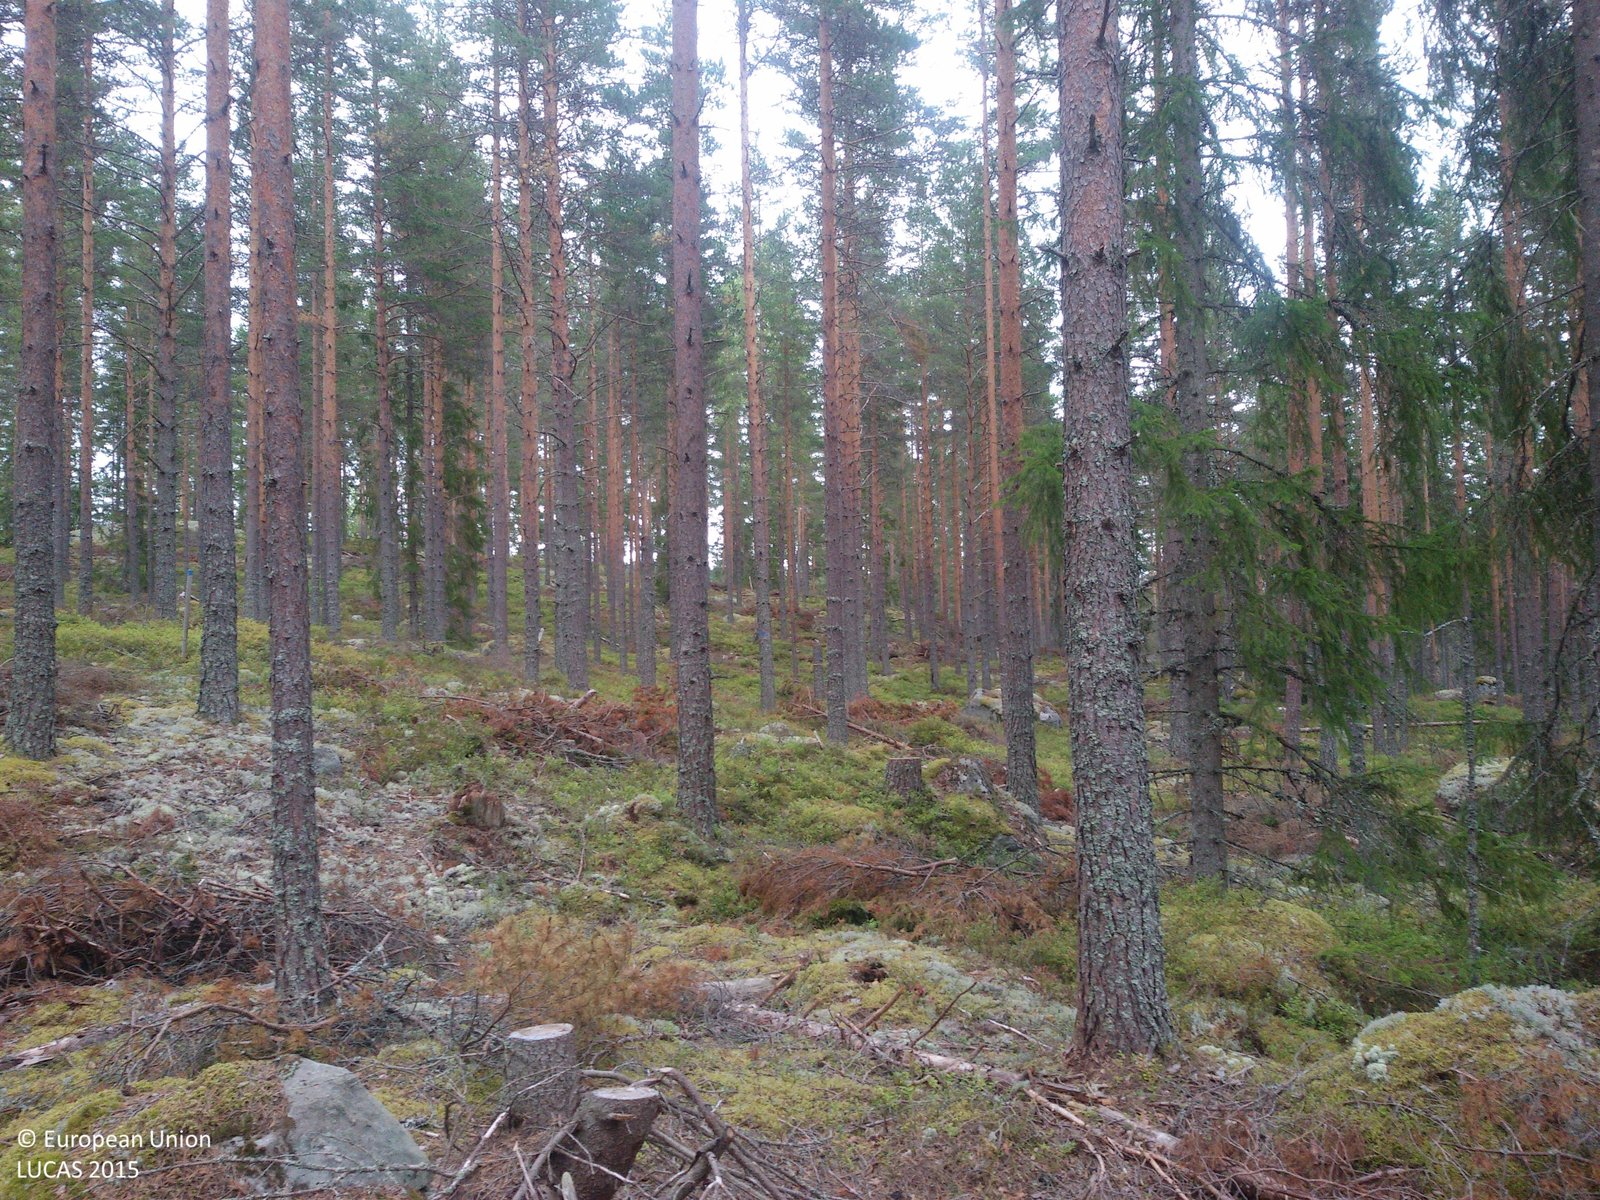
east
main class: Woodland
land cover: Pine dominated coniferous woodland
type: boreal forest
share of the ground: 50 - 75 %
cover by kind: coniferous forest trees 50 %, herbaceous plants 25 %, lichens and mosses 15 %, shrubs 10 %
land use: Forestry
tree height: > 5 m
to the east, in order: Pine dominated coniferous woodland
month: September
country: SE
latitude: 60.7713
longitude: 15.6597
